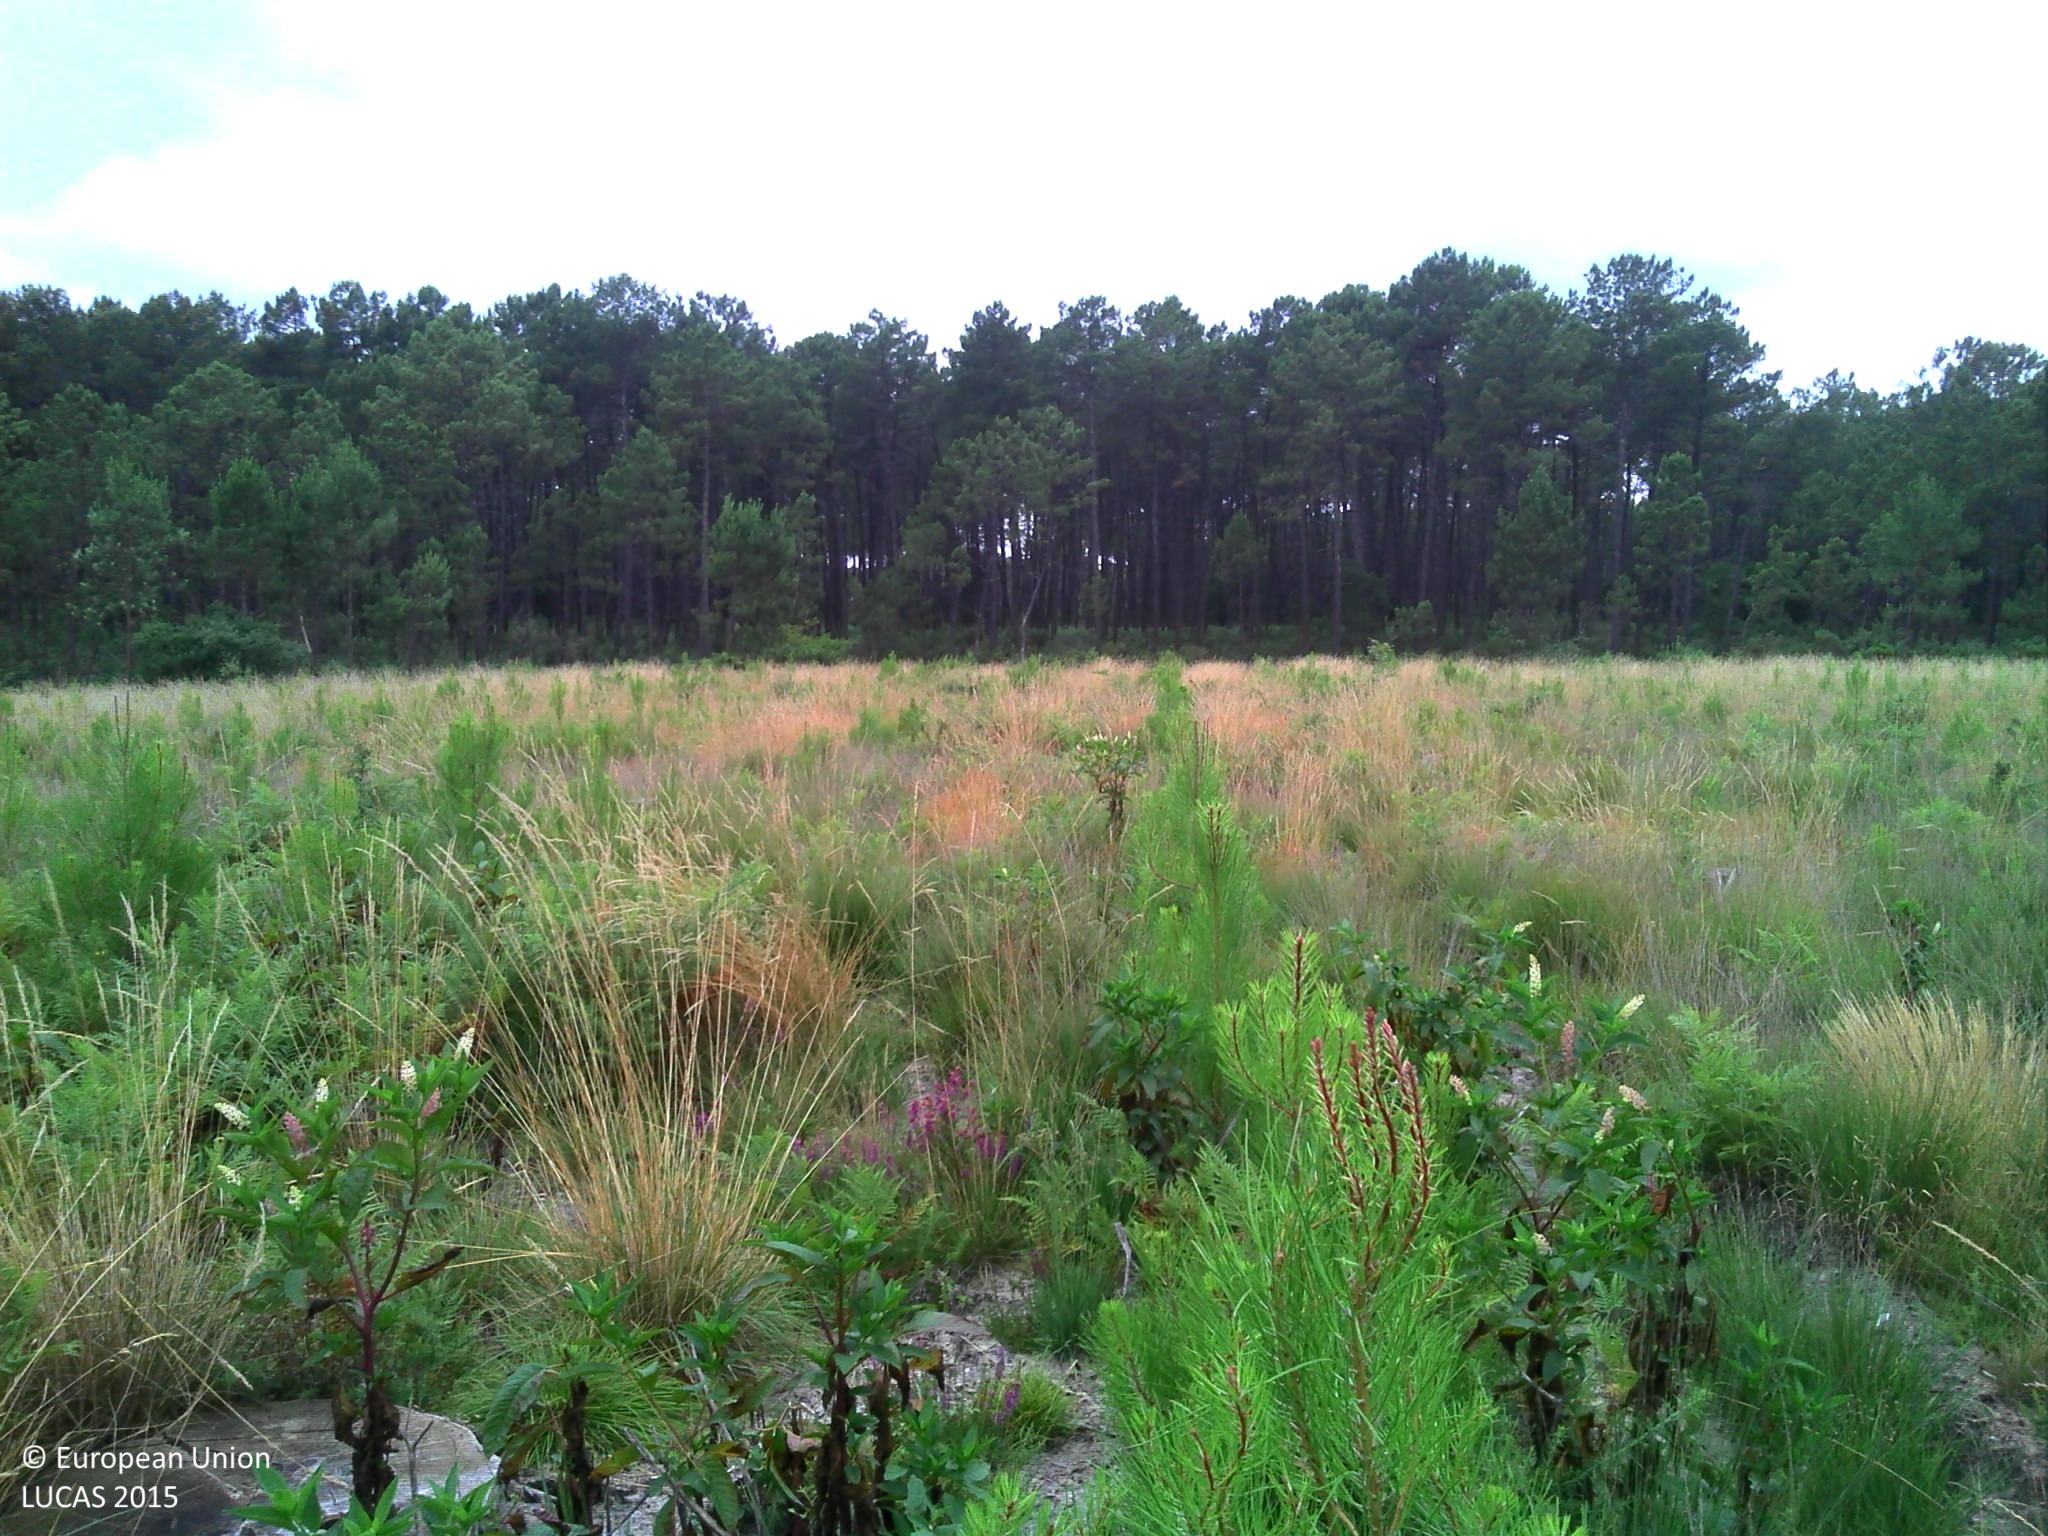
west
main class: Shrubland
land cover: Shrubland with sparse tree cover
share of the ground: > 75 %
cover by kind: shrubs 60 %, herbaceous plants 20 %, lichens and mosses 15 %, coniferous forest trees 5 %
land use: Forestry
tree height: > 5 m
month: July
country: FR
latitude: 43.6774
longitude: -1.2929
